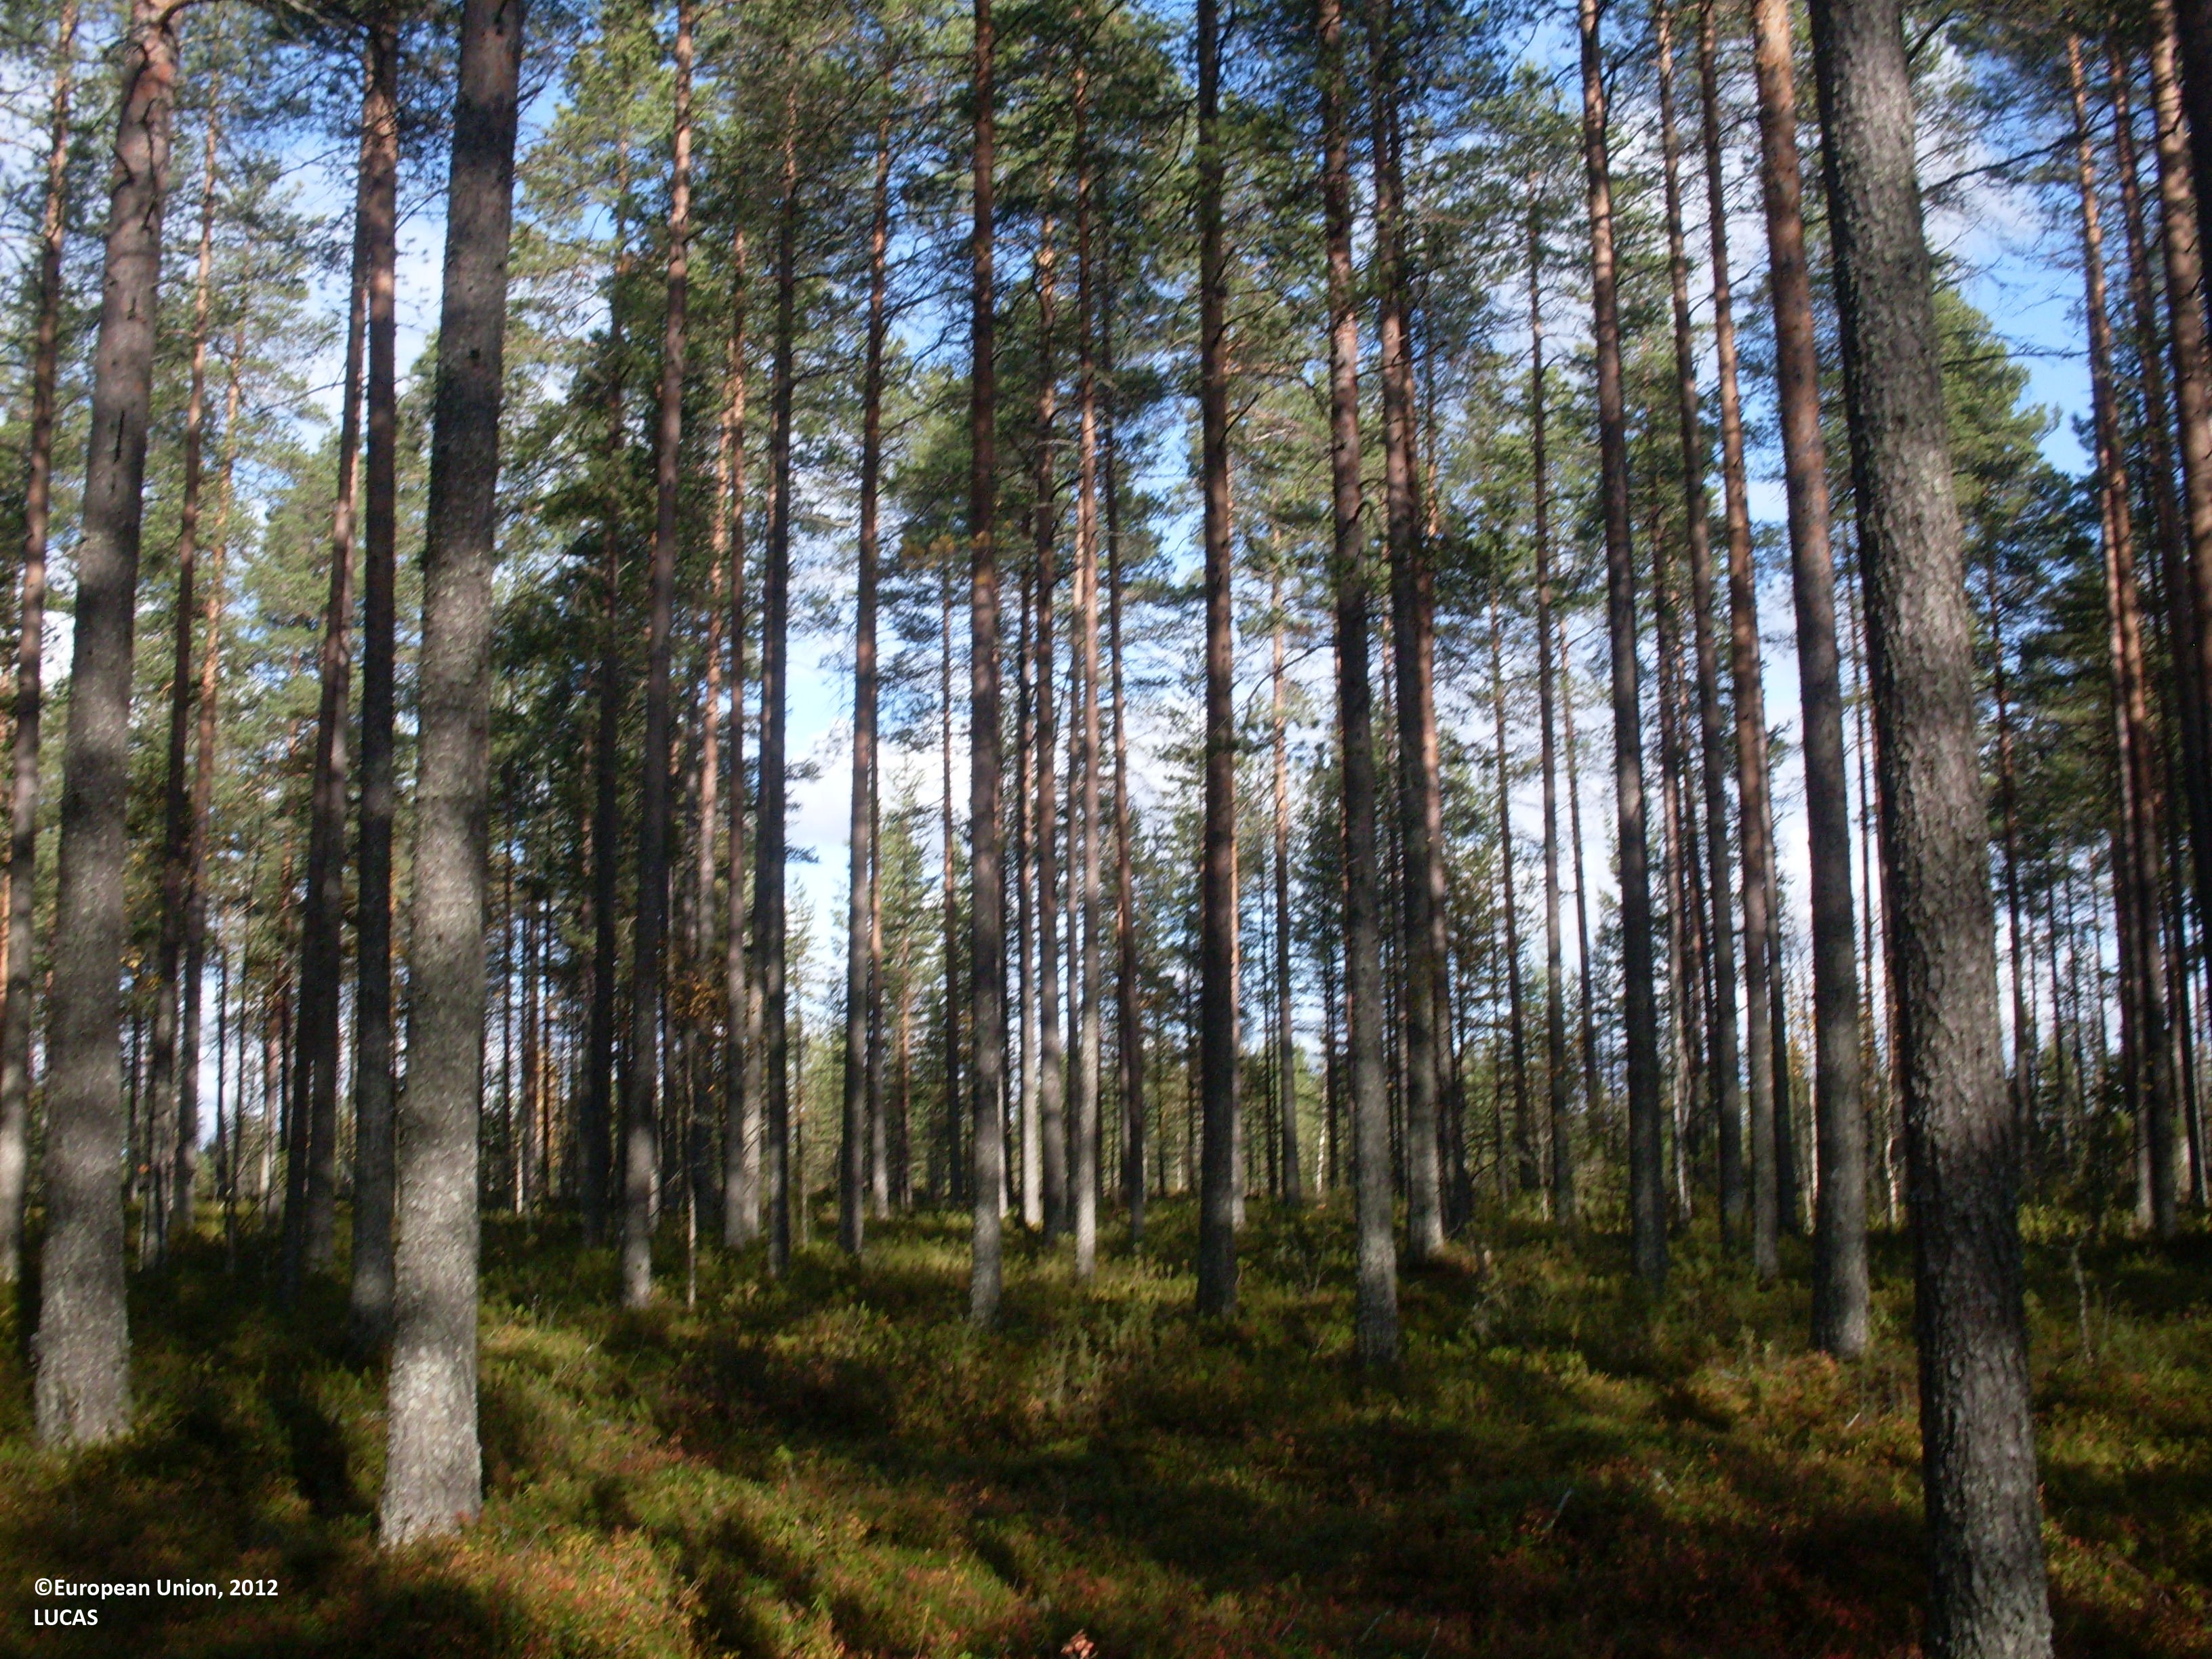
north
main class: Woodland
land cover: Pine dominated coniferous woodland
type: boreal forest
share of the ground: 50 - 75 %
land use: Forestry
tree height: > 5 m
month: September
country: FI
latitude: 64.7439
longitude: 29.3399
